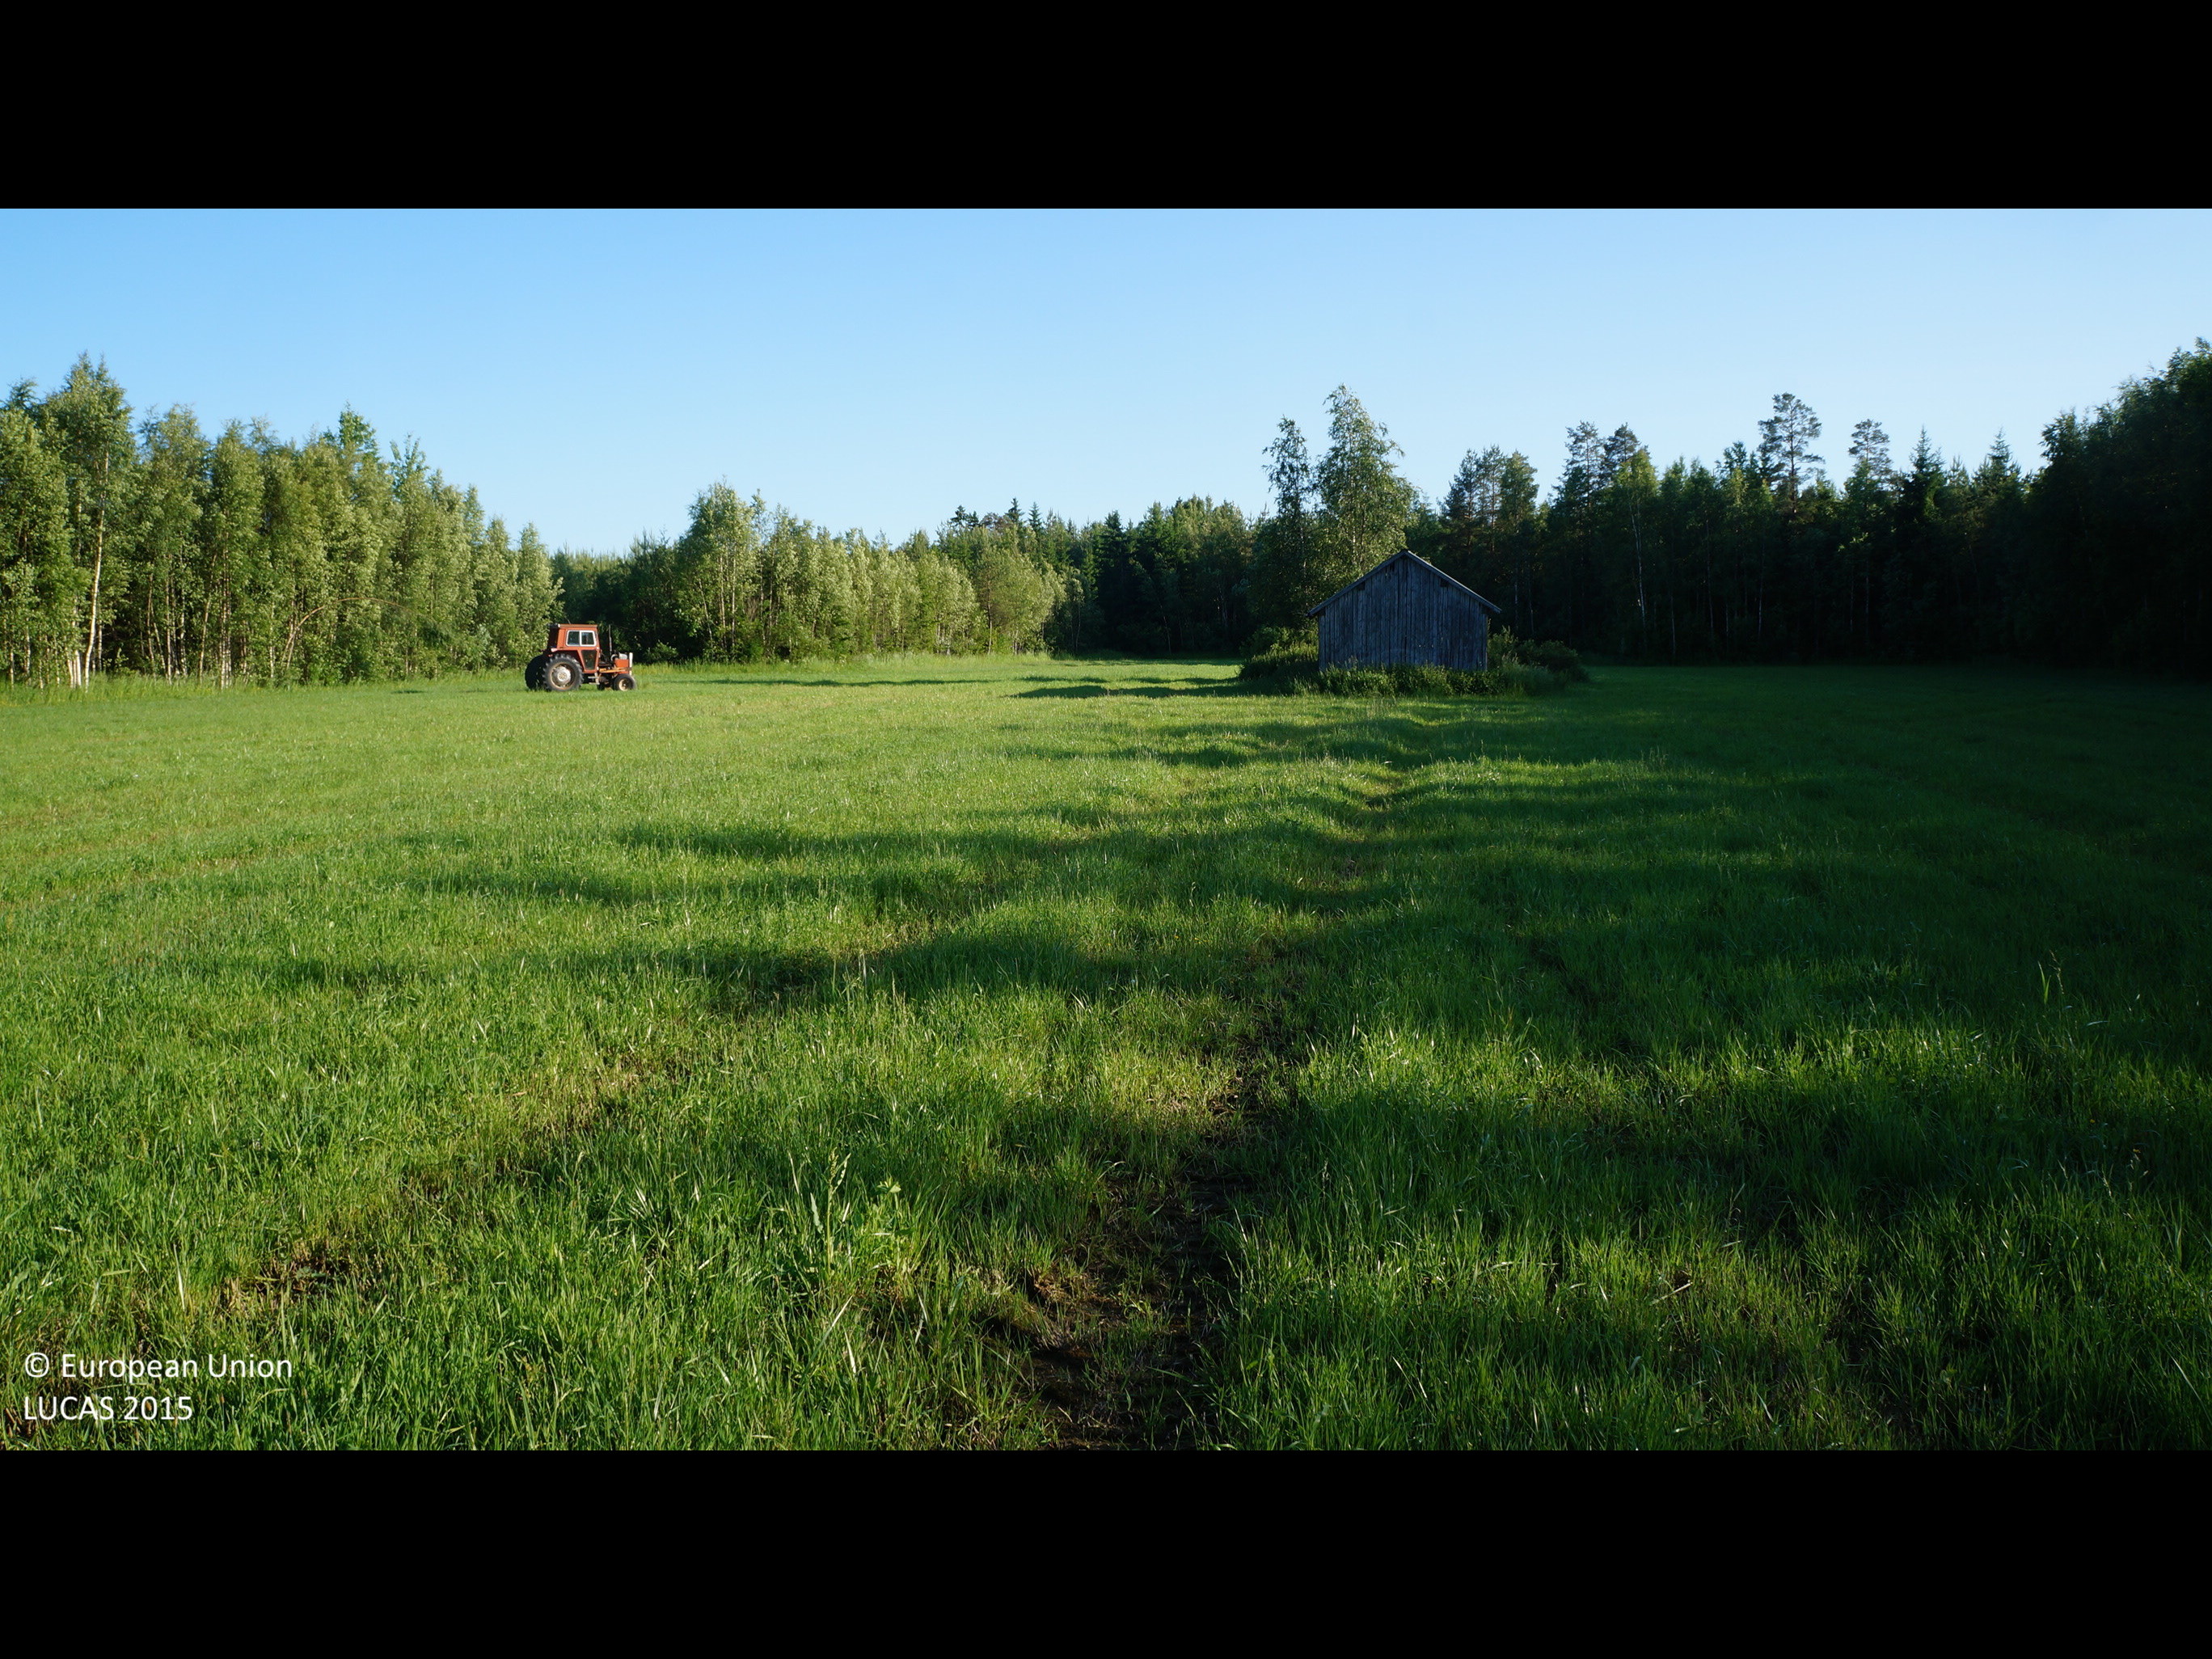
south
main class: Cropland
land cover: Temporary grasslands
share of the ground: 50 - 75 %
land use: Agriculture (excluding fallow land and kitchen gardens)
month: July
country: FI
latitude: 63.6511
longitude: 22.8745
